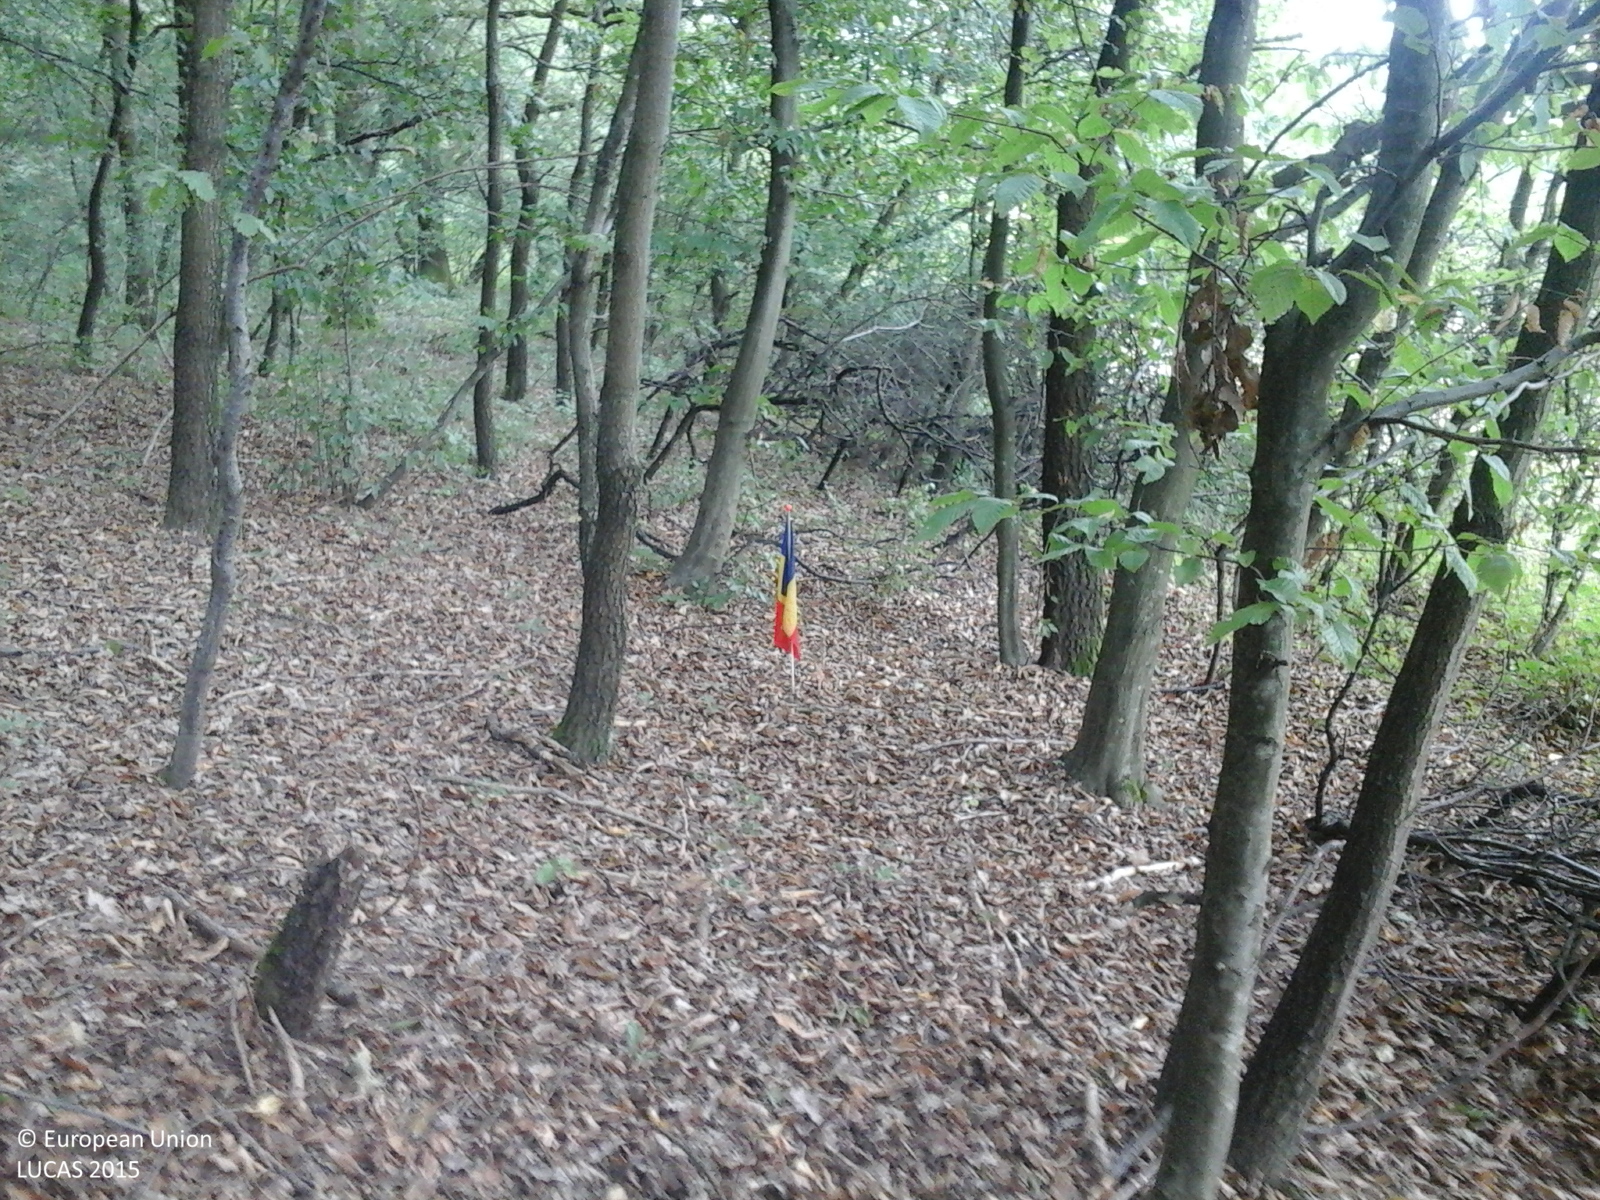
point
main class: Woodland
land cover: Broadleaved woodland
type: acidophilous oak and oak-birch forest
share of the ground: > 75 %
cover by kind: broadleaved forest trees 100 %
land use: Forestry
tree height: > 5 m
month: September
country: RO
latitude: 47.2400
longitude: 23.0770
